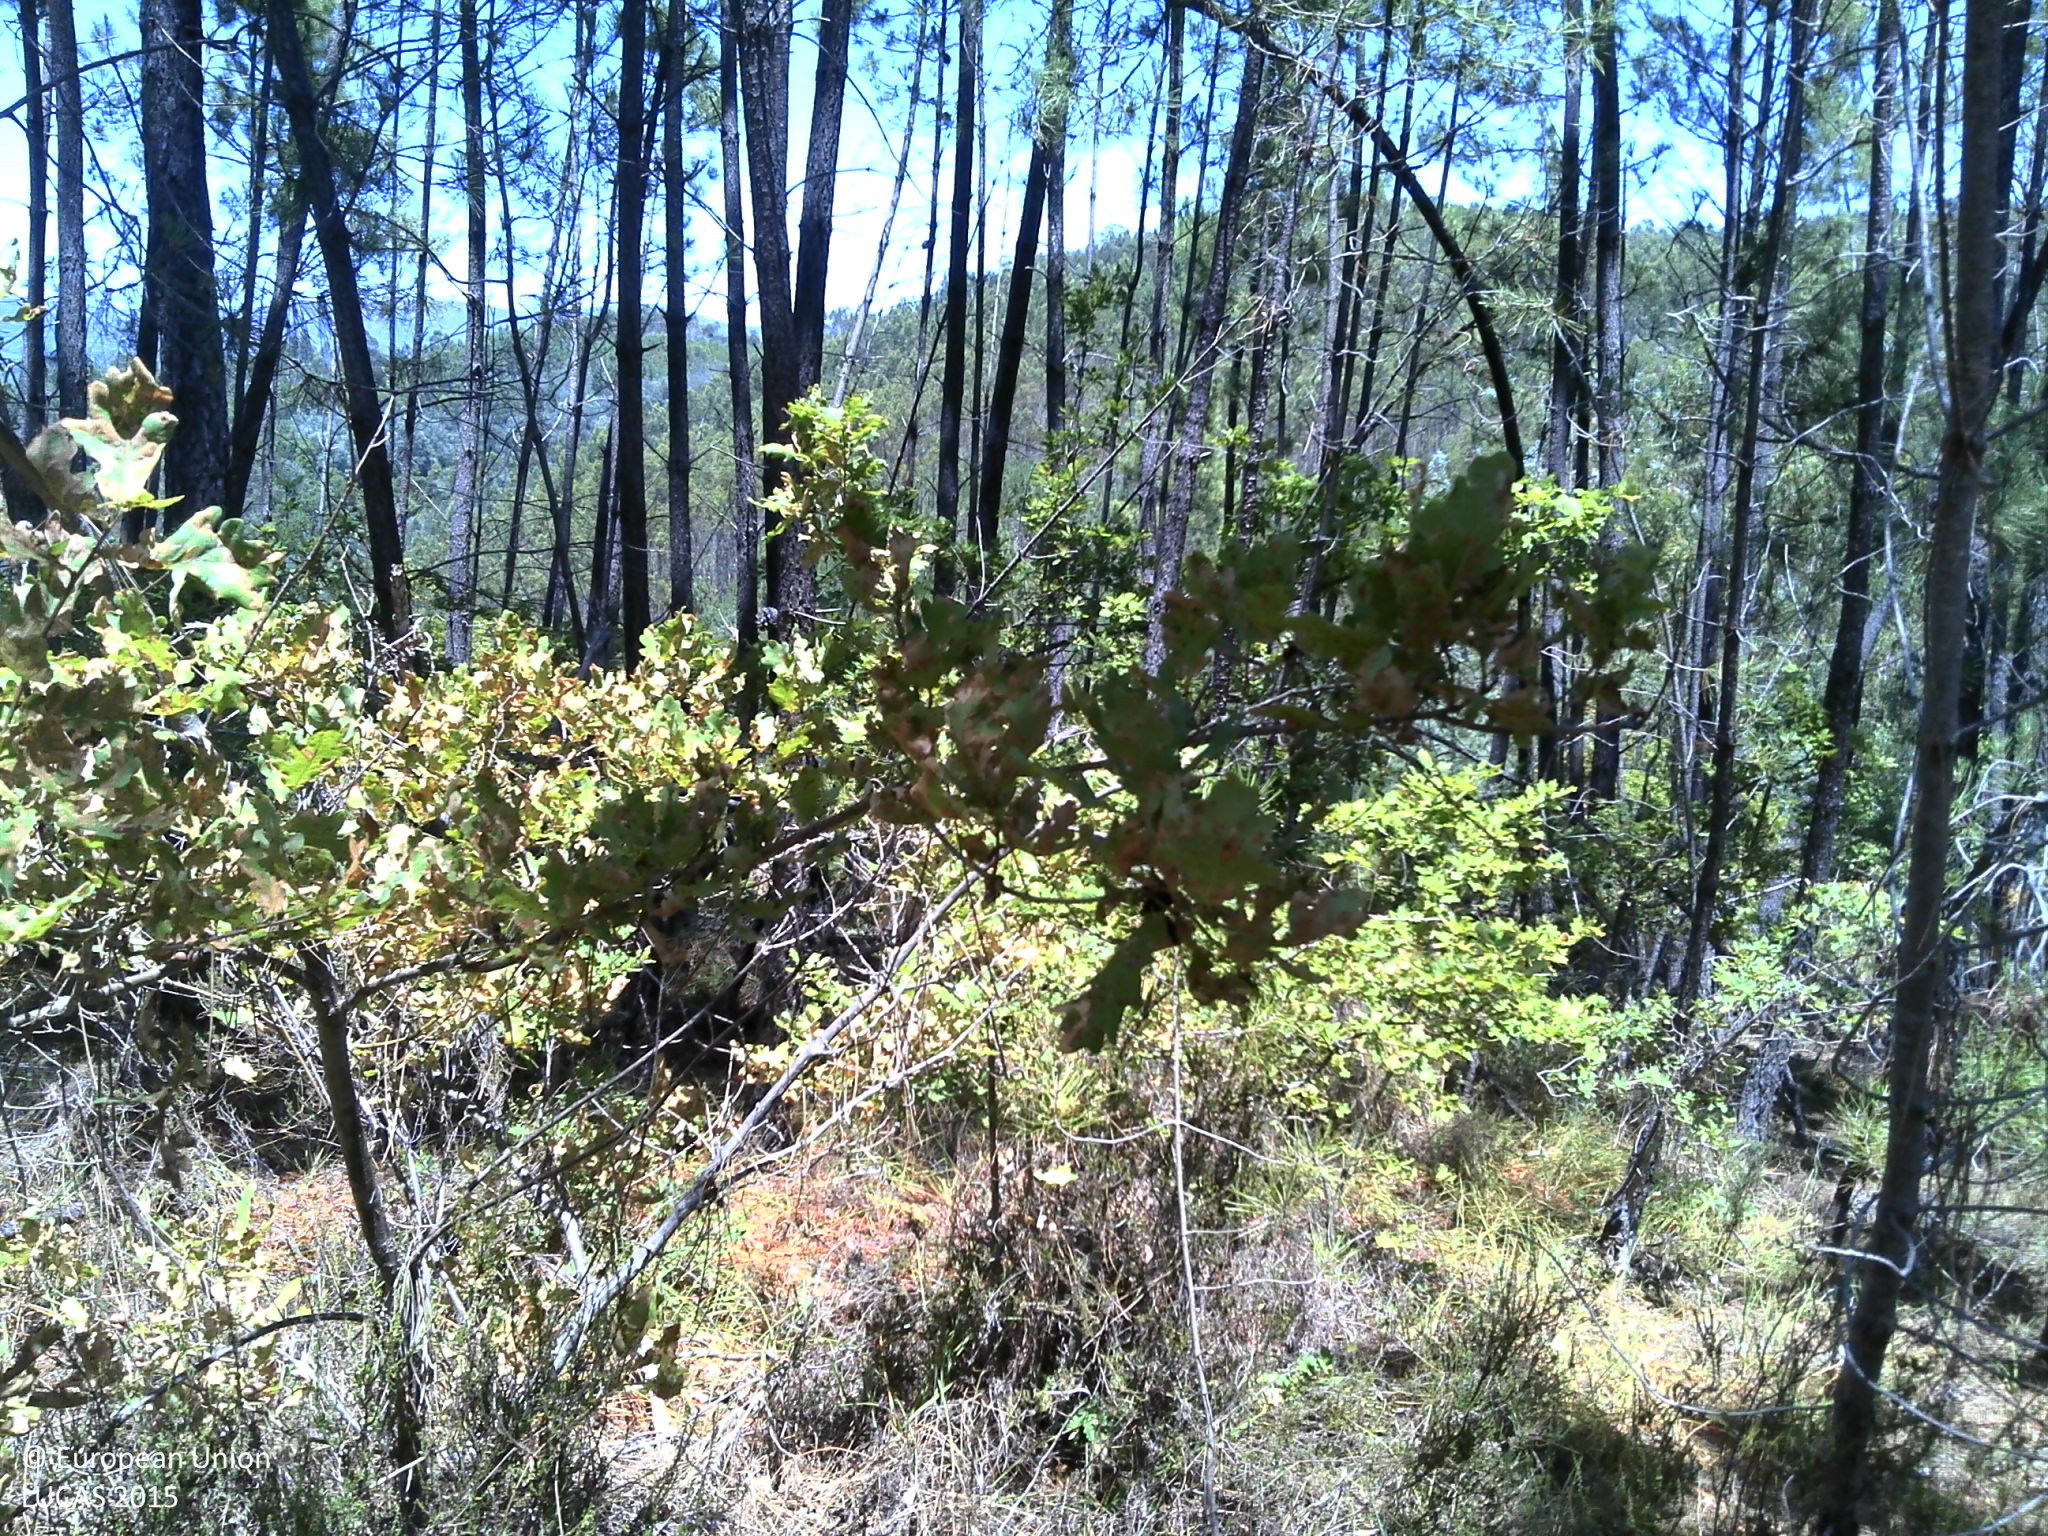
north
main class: Woodland
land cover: Pine dominated mixed woodland
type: coniferous forest of the mediterranean region
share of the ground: 10 - 25 %
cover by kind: shrubs 40 %, unconsolidated bare surface 30 %, coniferous forest trees 15 %, herbaceous plants 10 %, broadleaved forest trees 5 %
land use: Forestry
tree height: > 5 m
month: July
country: PT
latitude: 39.9530
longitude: -8.2043
